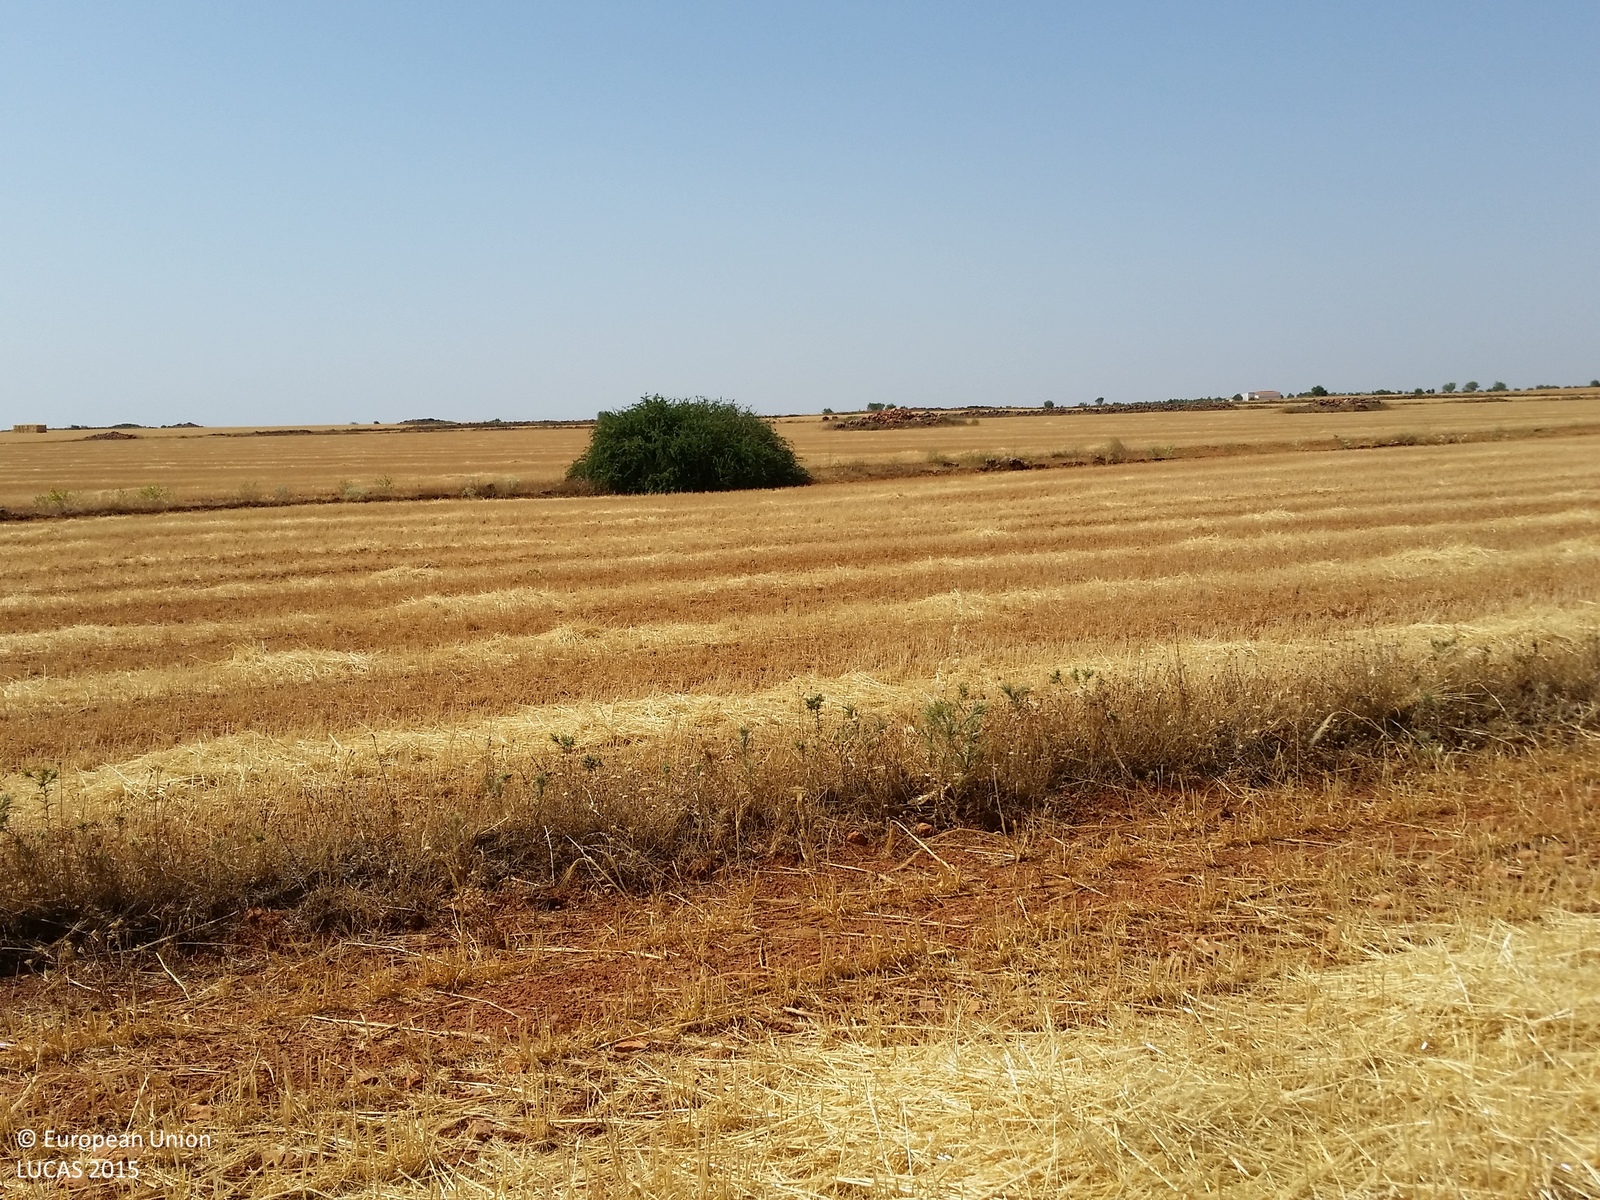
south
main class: Cropland
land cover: Barley
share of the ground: < 10 %
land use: Agriculture (excluding fallow land and kitchen gardens)
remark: Harvested field
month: July
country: ES
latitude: 38.8836
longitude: -2.6050
